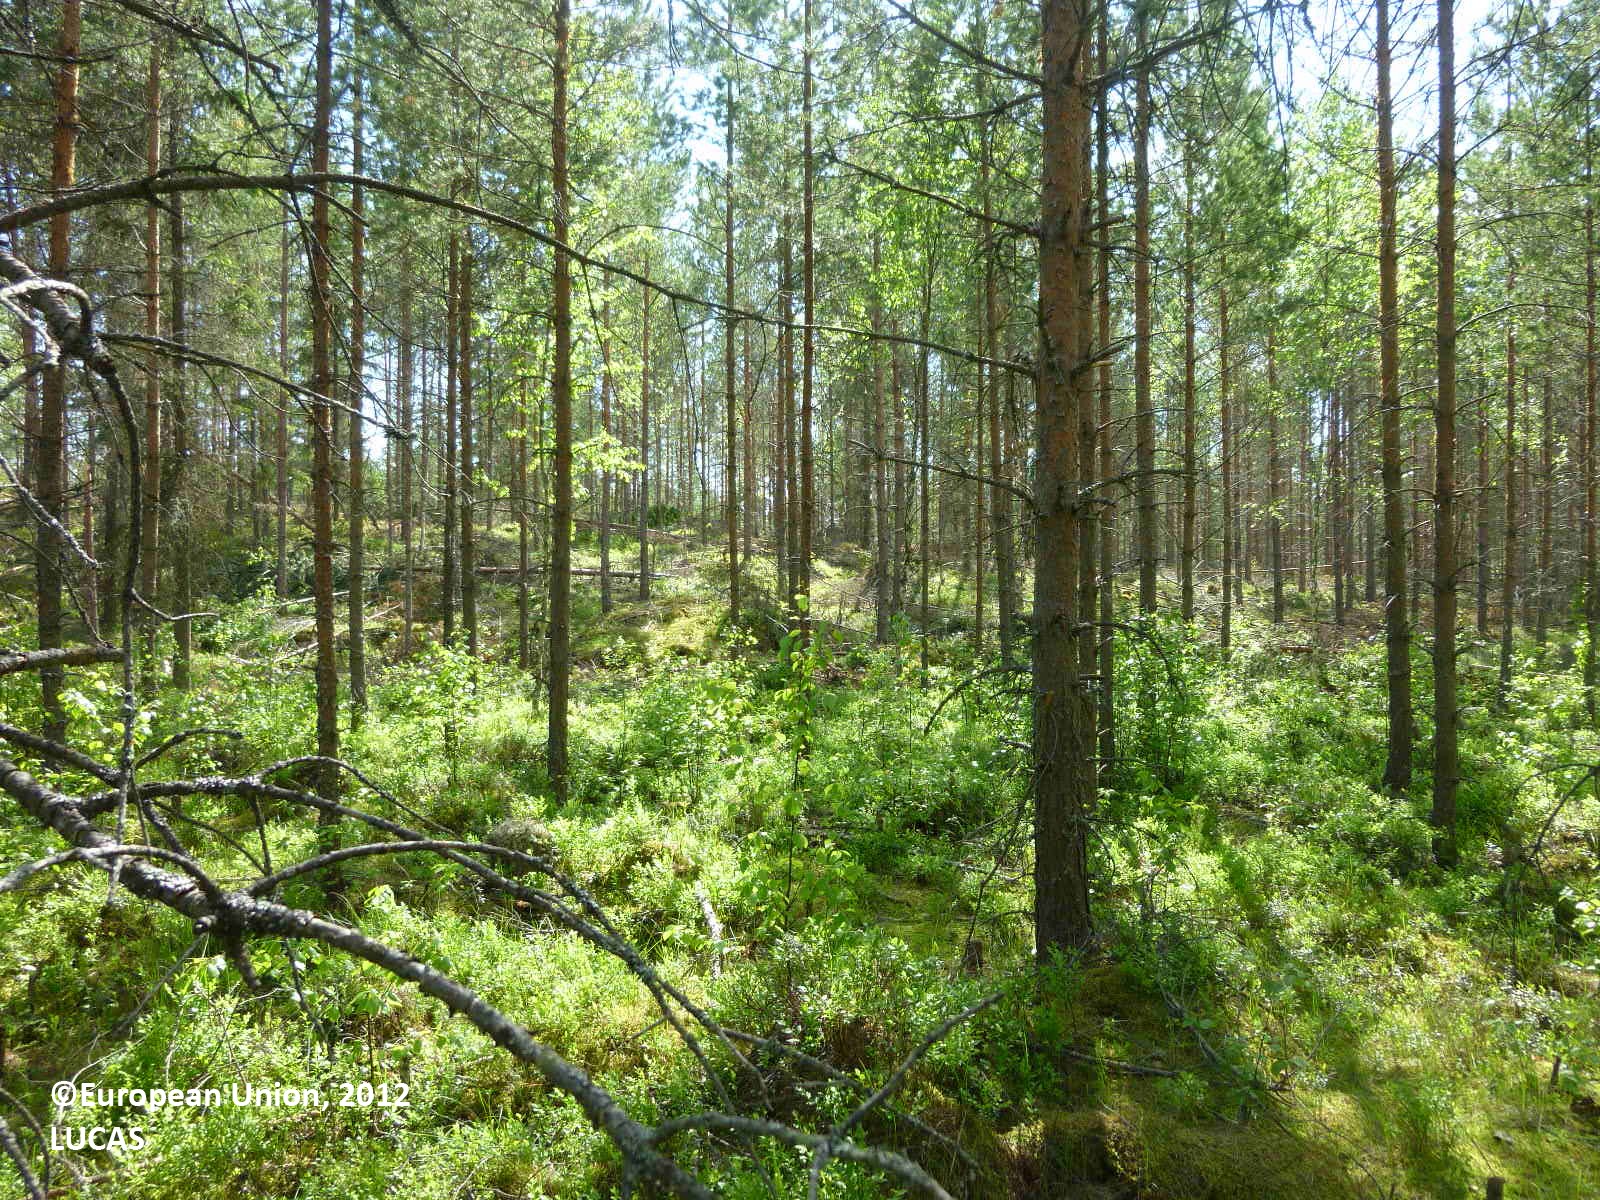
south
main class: Woodland
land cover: Pine dominated mixed woodland
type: boreal forest
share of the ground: 50 - 75 %
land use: Forestry
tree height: > 5 m
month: June
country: FI
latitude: 61.4442
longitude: 22.7637
